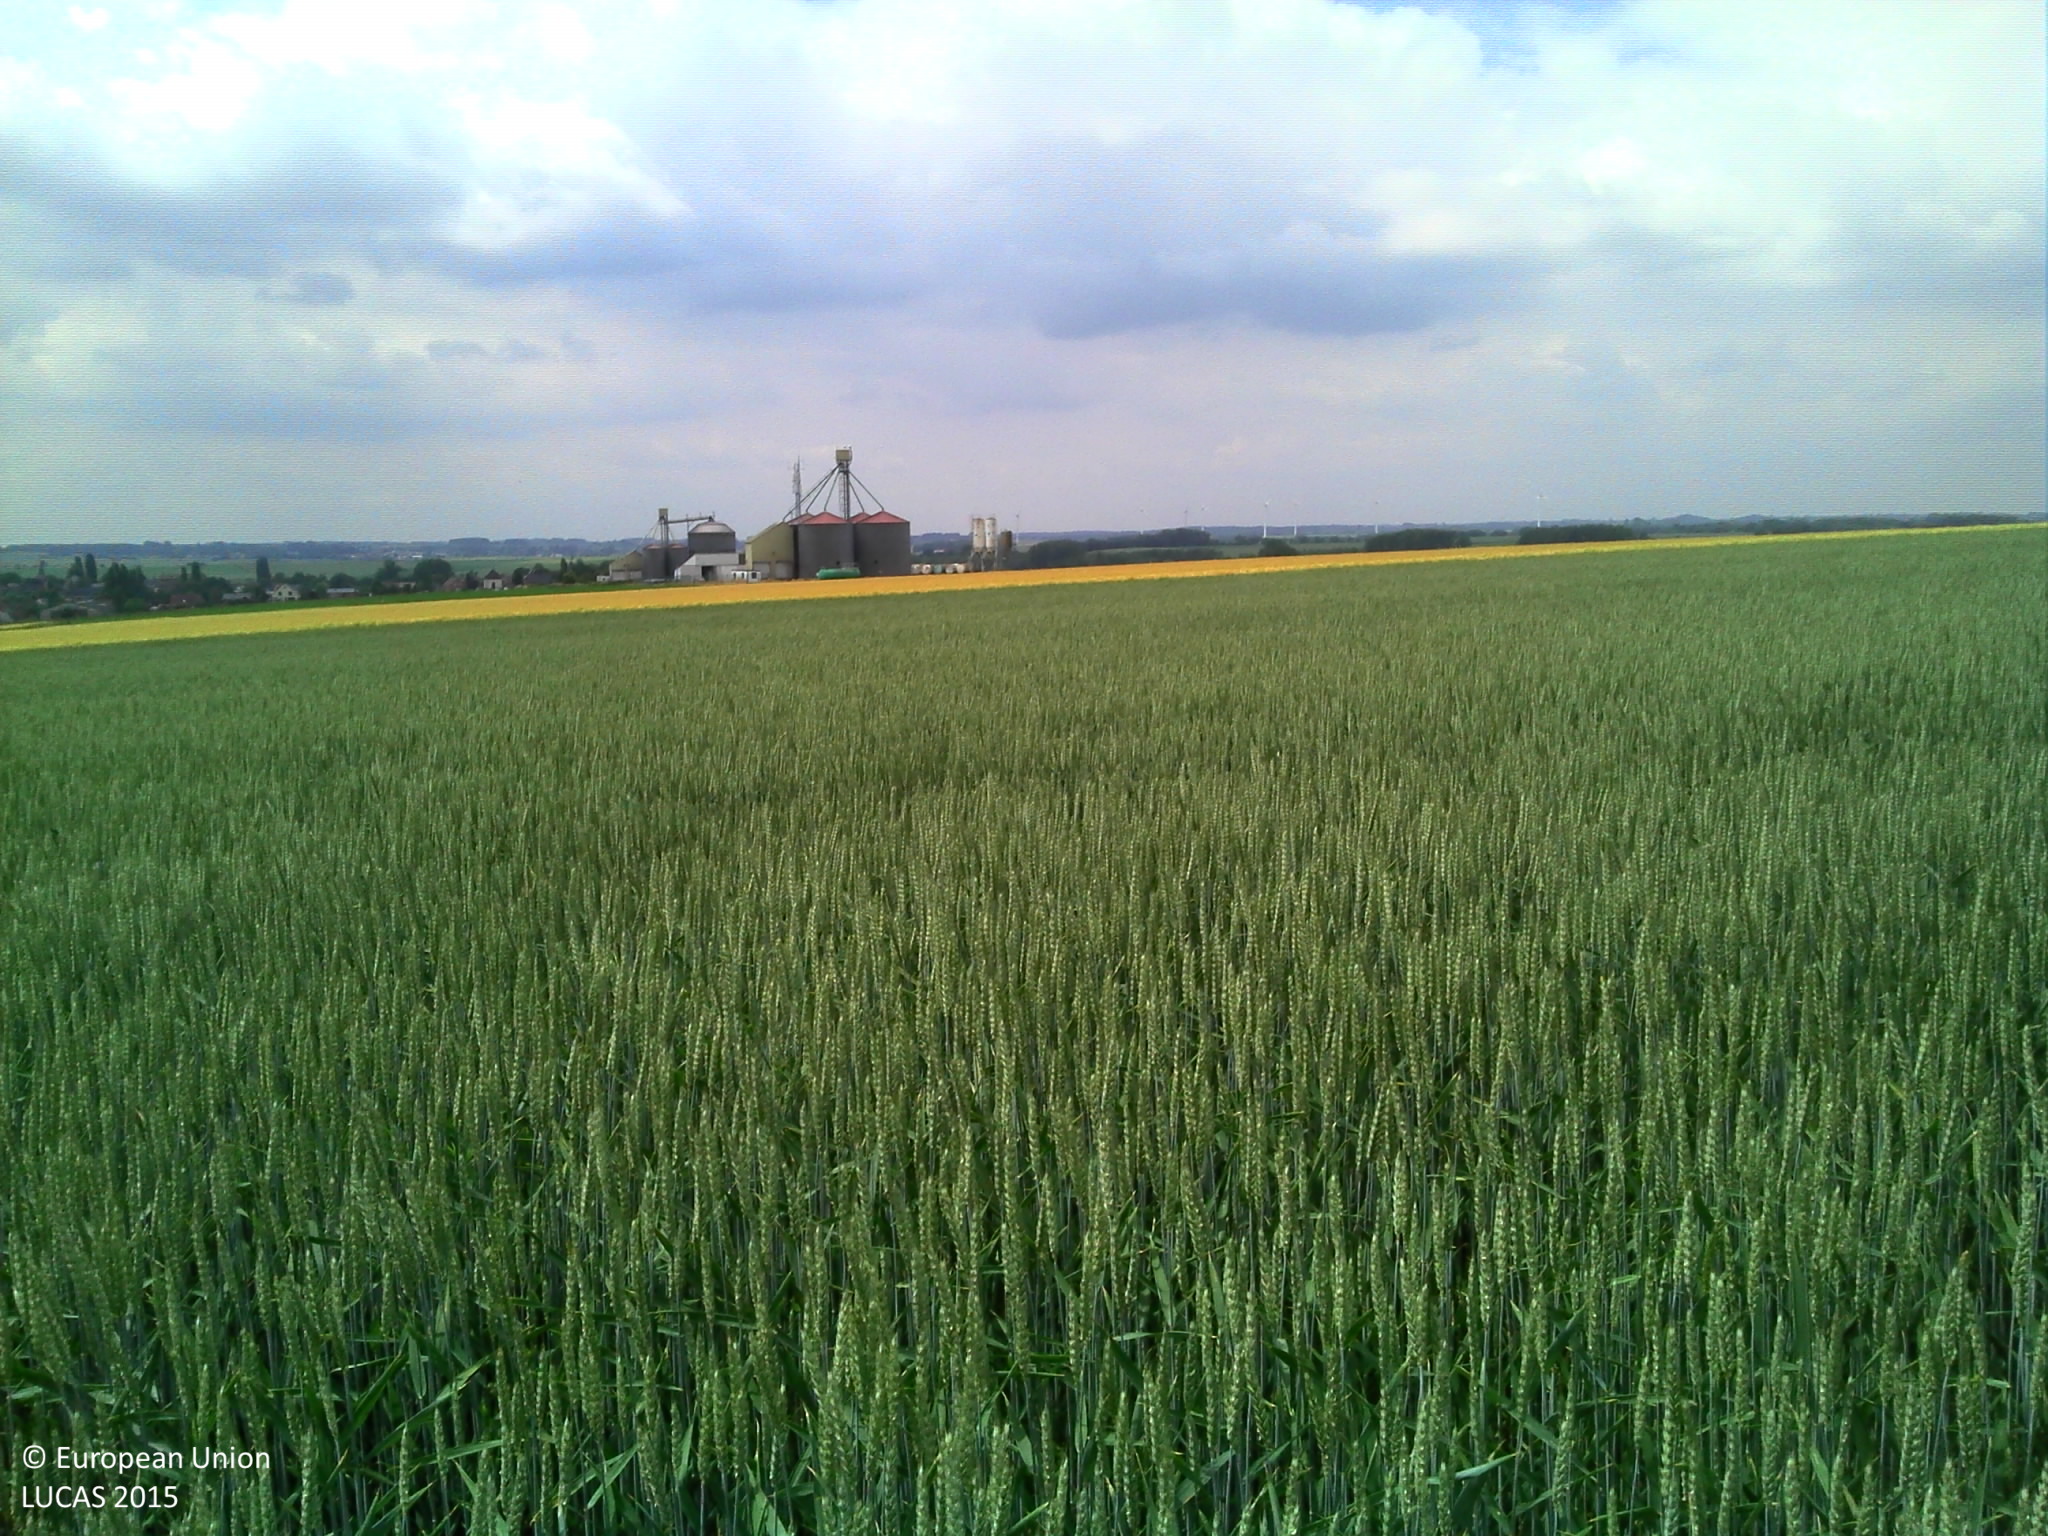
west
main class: Cropland
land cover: Barley
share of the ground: > 75 %
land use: Agriculture (excluding fallow land and kitchen gardens)
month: June
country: BE
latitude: 50.3892
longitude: 4.0448
